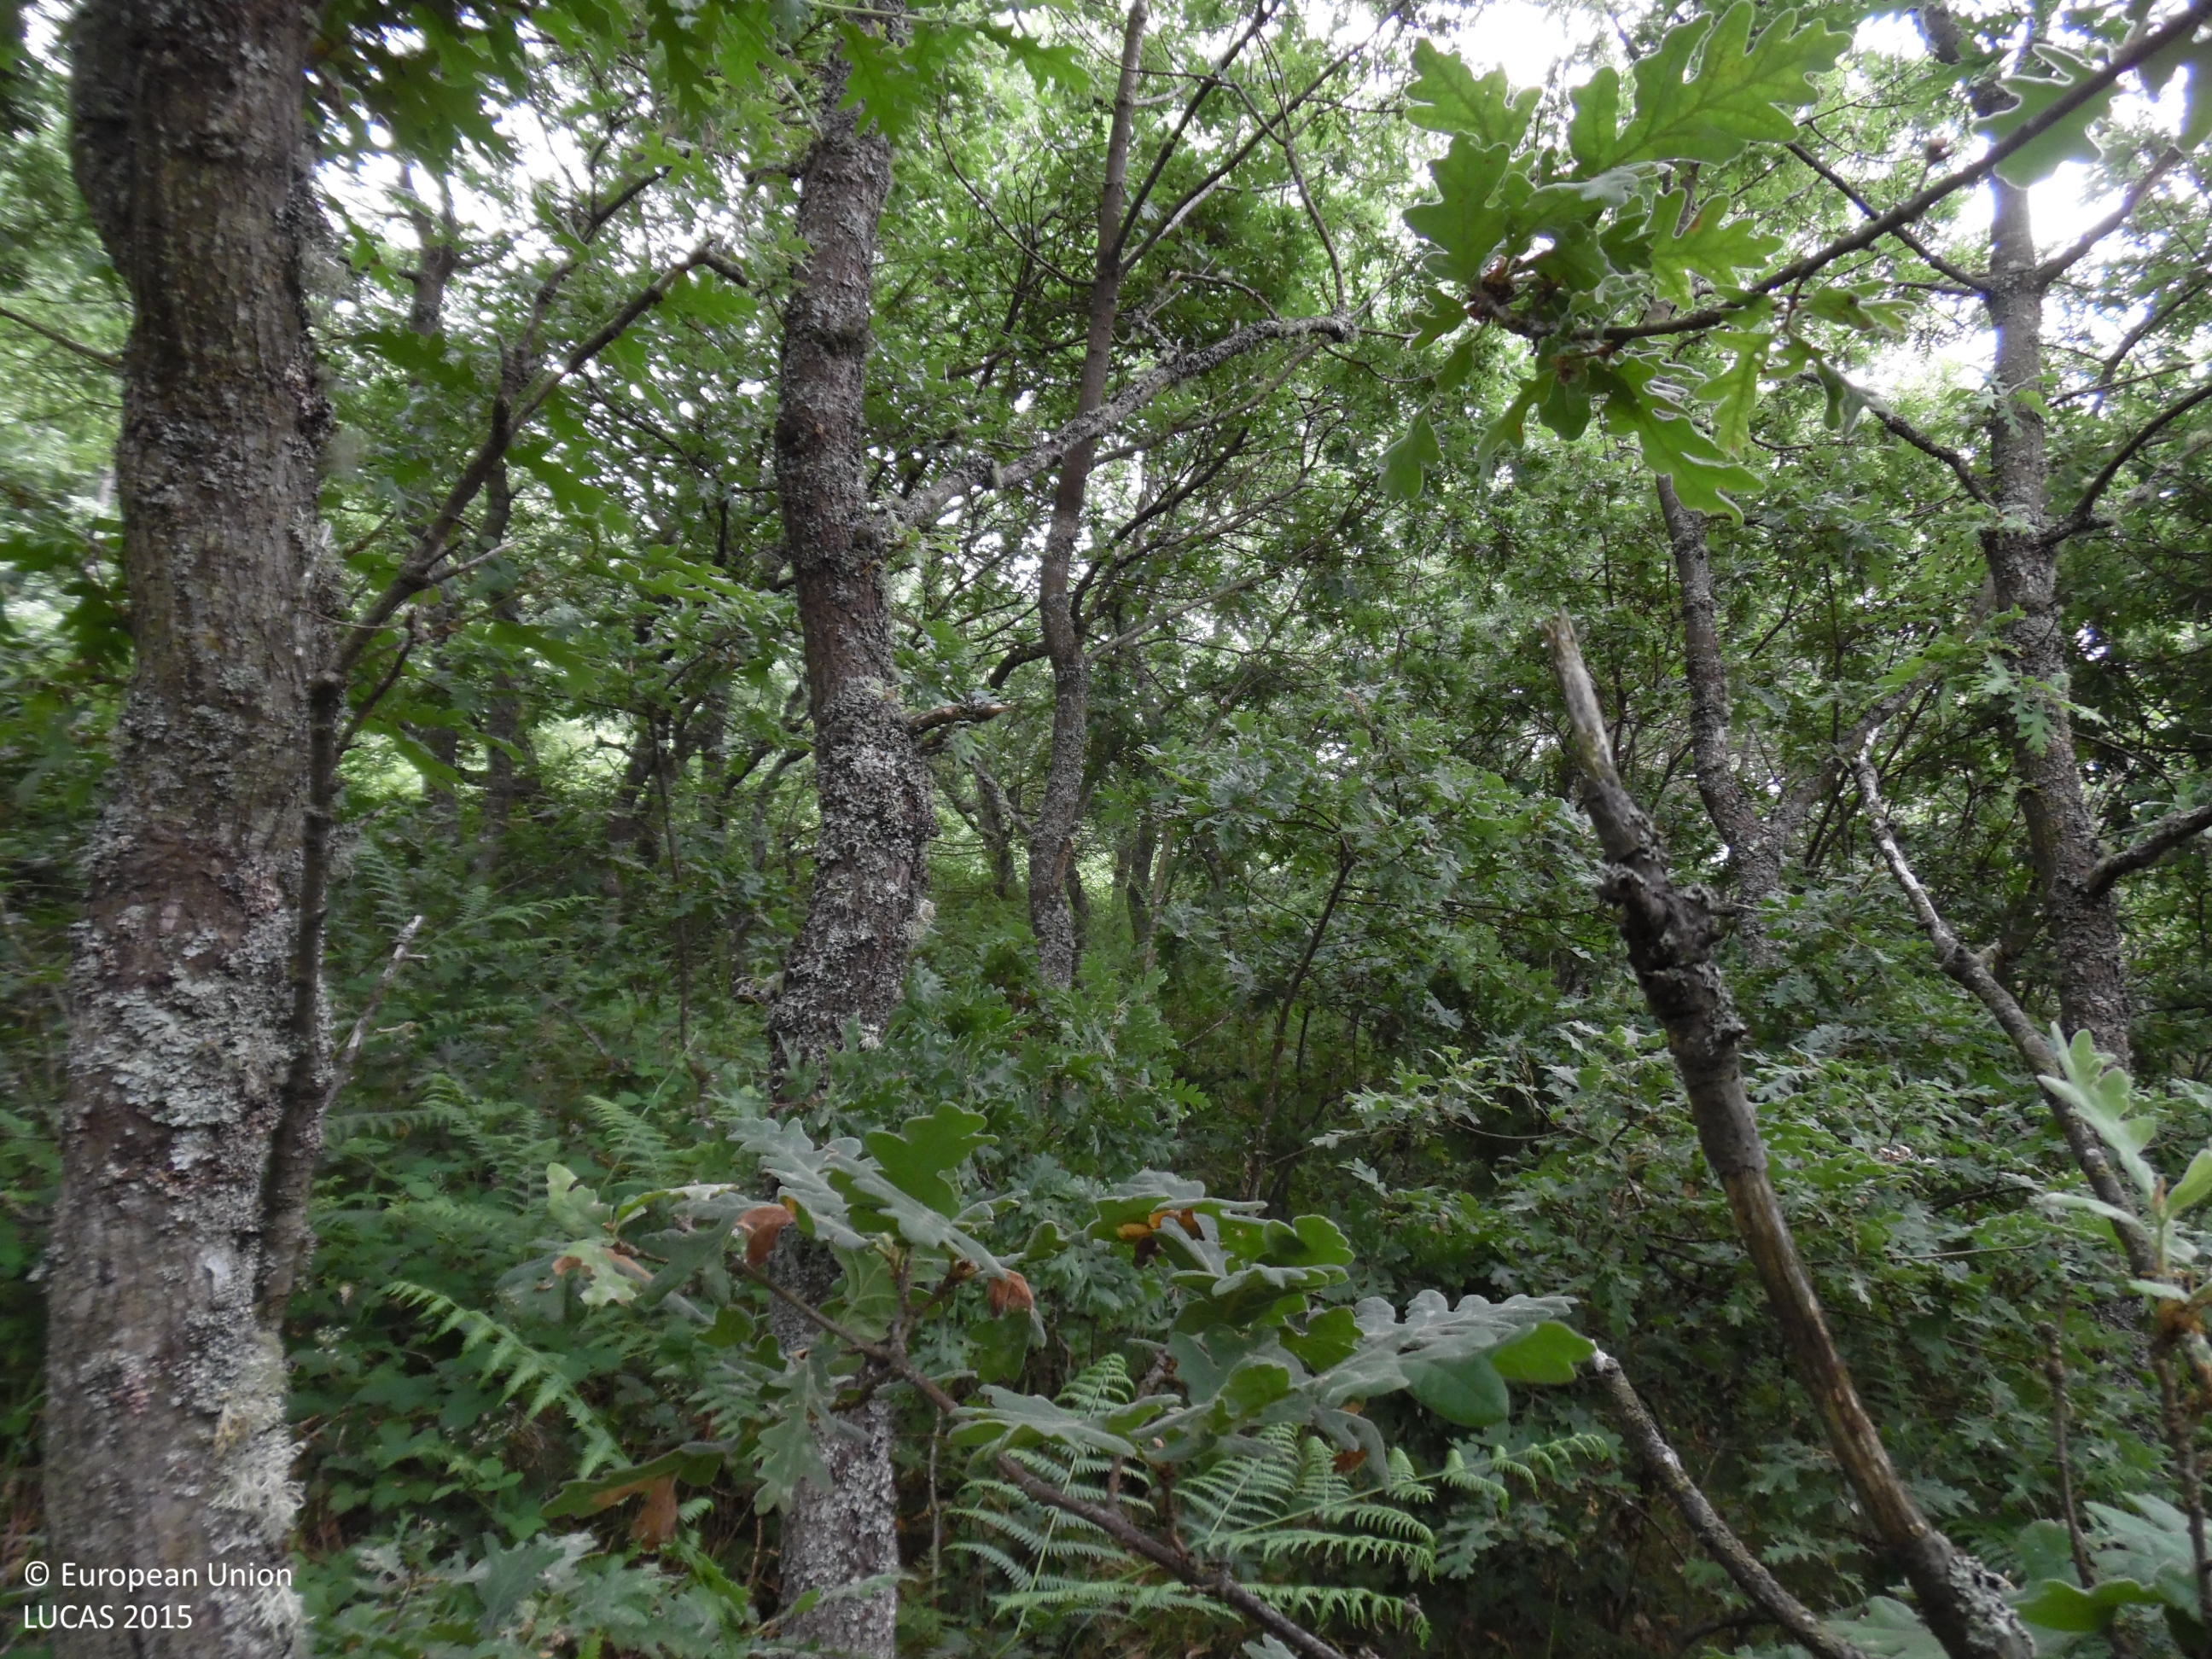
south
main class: Woodland
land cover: Broadleaved woodland
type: thermophilous deciduous forest
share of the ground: > 75 %
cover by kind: broadleaved forest trees 90 %, shrubs 5 %, consolidated bare surface 5 %
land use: Forestry
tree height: > 5 m
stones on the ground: < 10 %
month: July
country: ES
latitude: 43.1895
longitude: -6.5787
